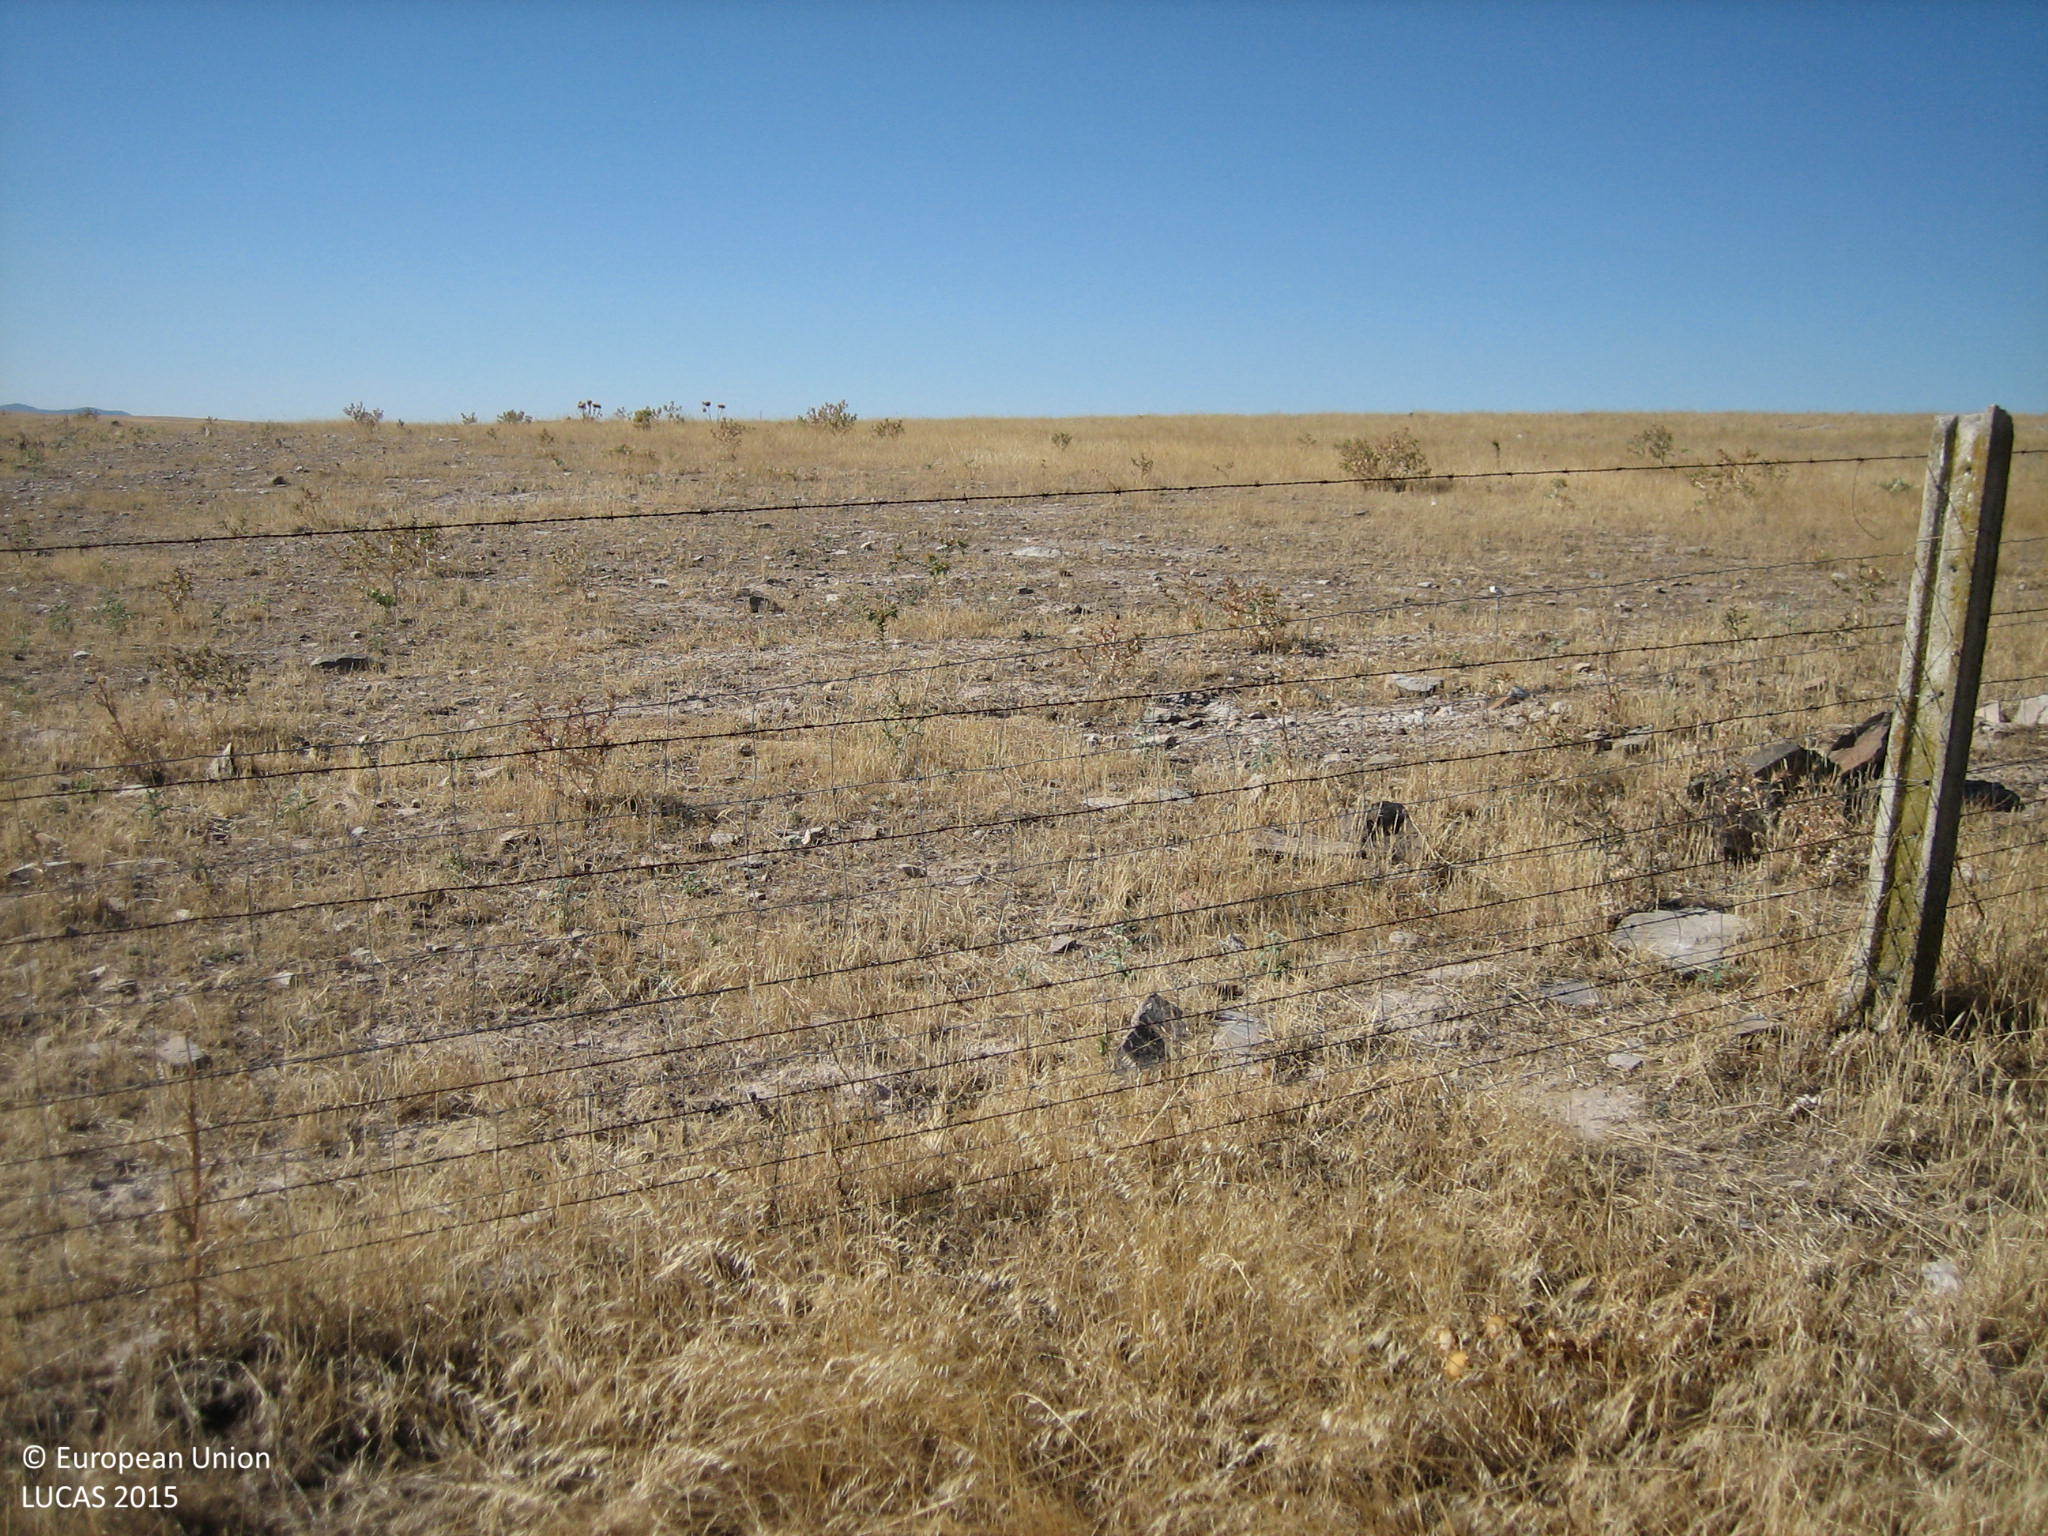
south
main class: Grassland
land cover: Spontaneously vegetated surfaces
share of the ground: > 75 %
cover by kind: herbaceous plants 100 %
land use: Fallow land
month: July
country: ES
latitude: 38.3710
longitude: -6.1256
